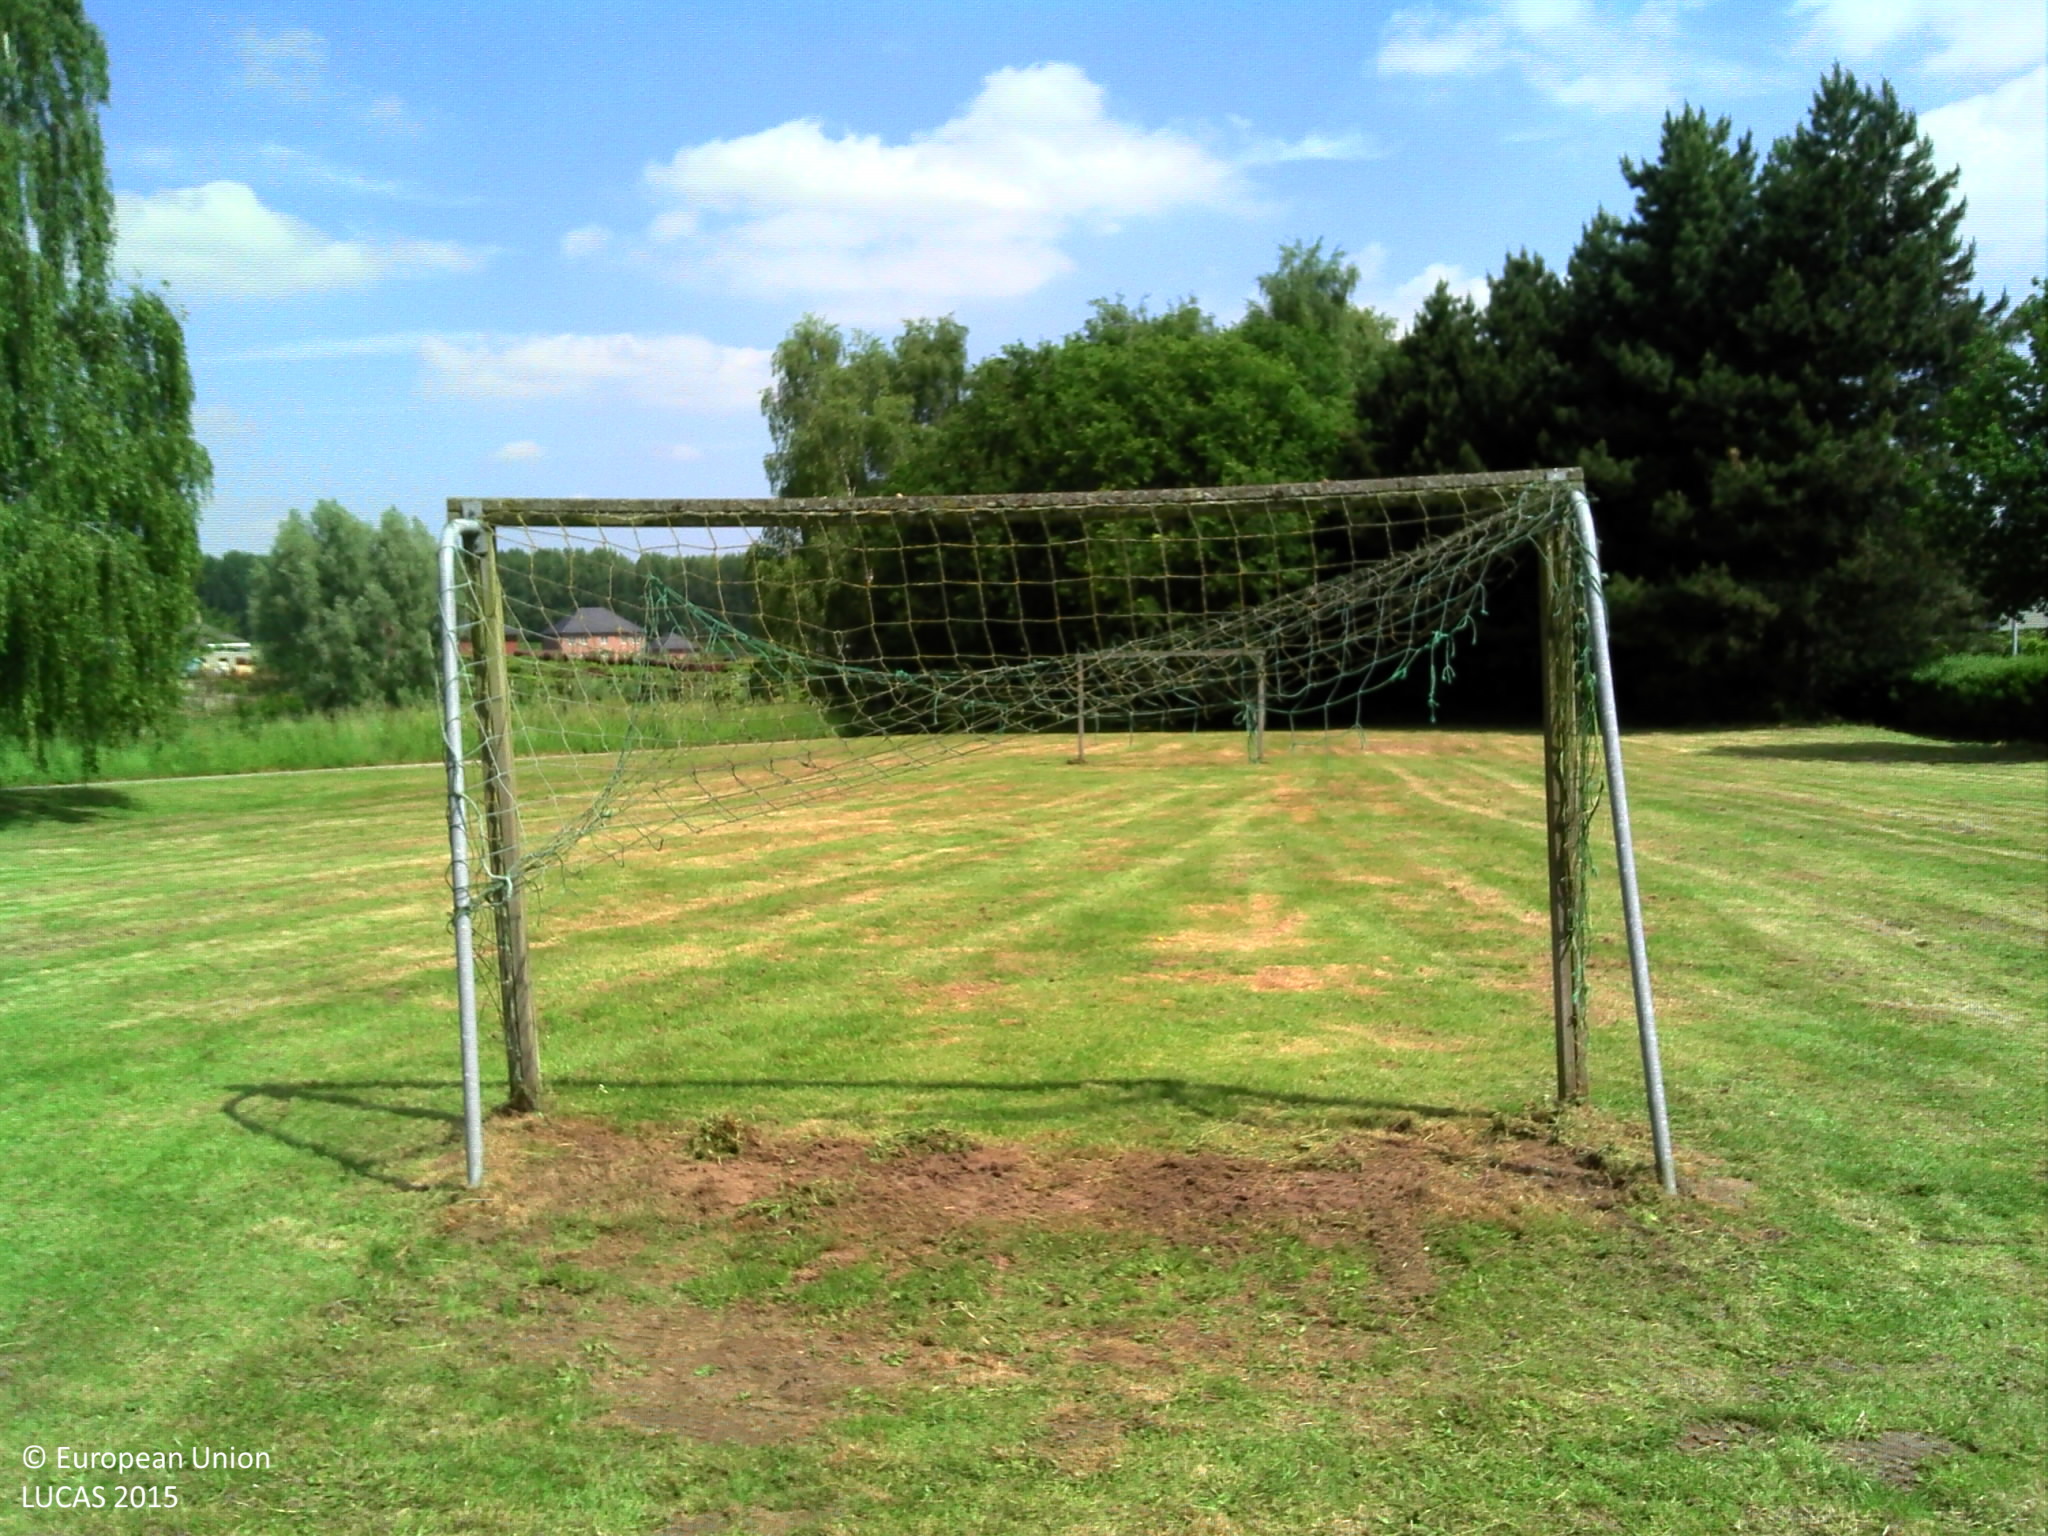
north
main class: Grassland
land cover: Grassland without tree/shrub cover
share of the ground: > 75 %
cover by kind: herbaceous plants 100 %
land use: Sport
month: June
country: BE
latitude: 50.9012
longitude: 3.8365
